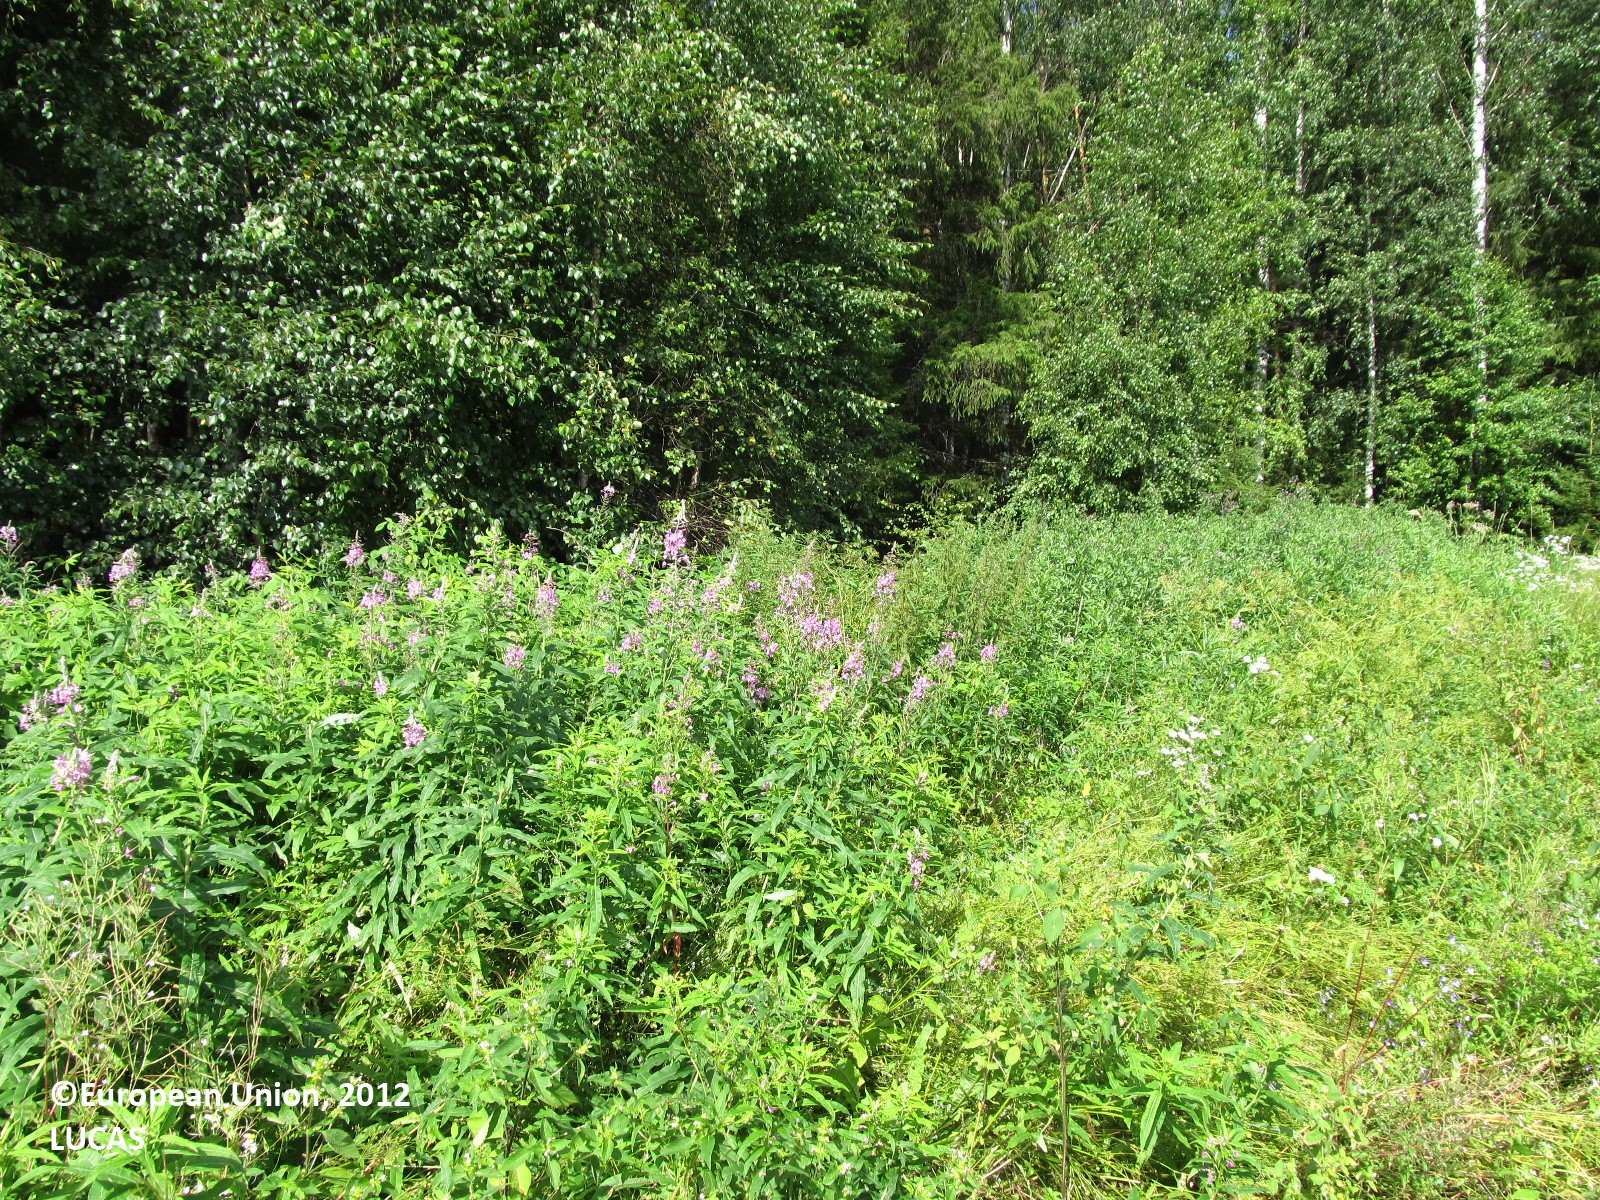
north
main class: Grassland
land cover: Grassland without tree/shrub cover
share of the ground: > 75 %
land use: Fallow land
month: July
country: FI
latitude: 61.9300
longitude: 28.0806
